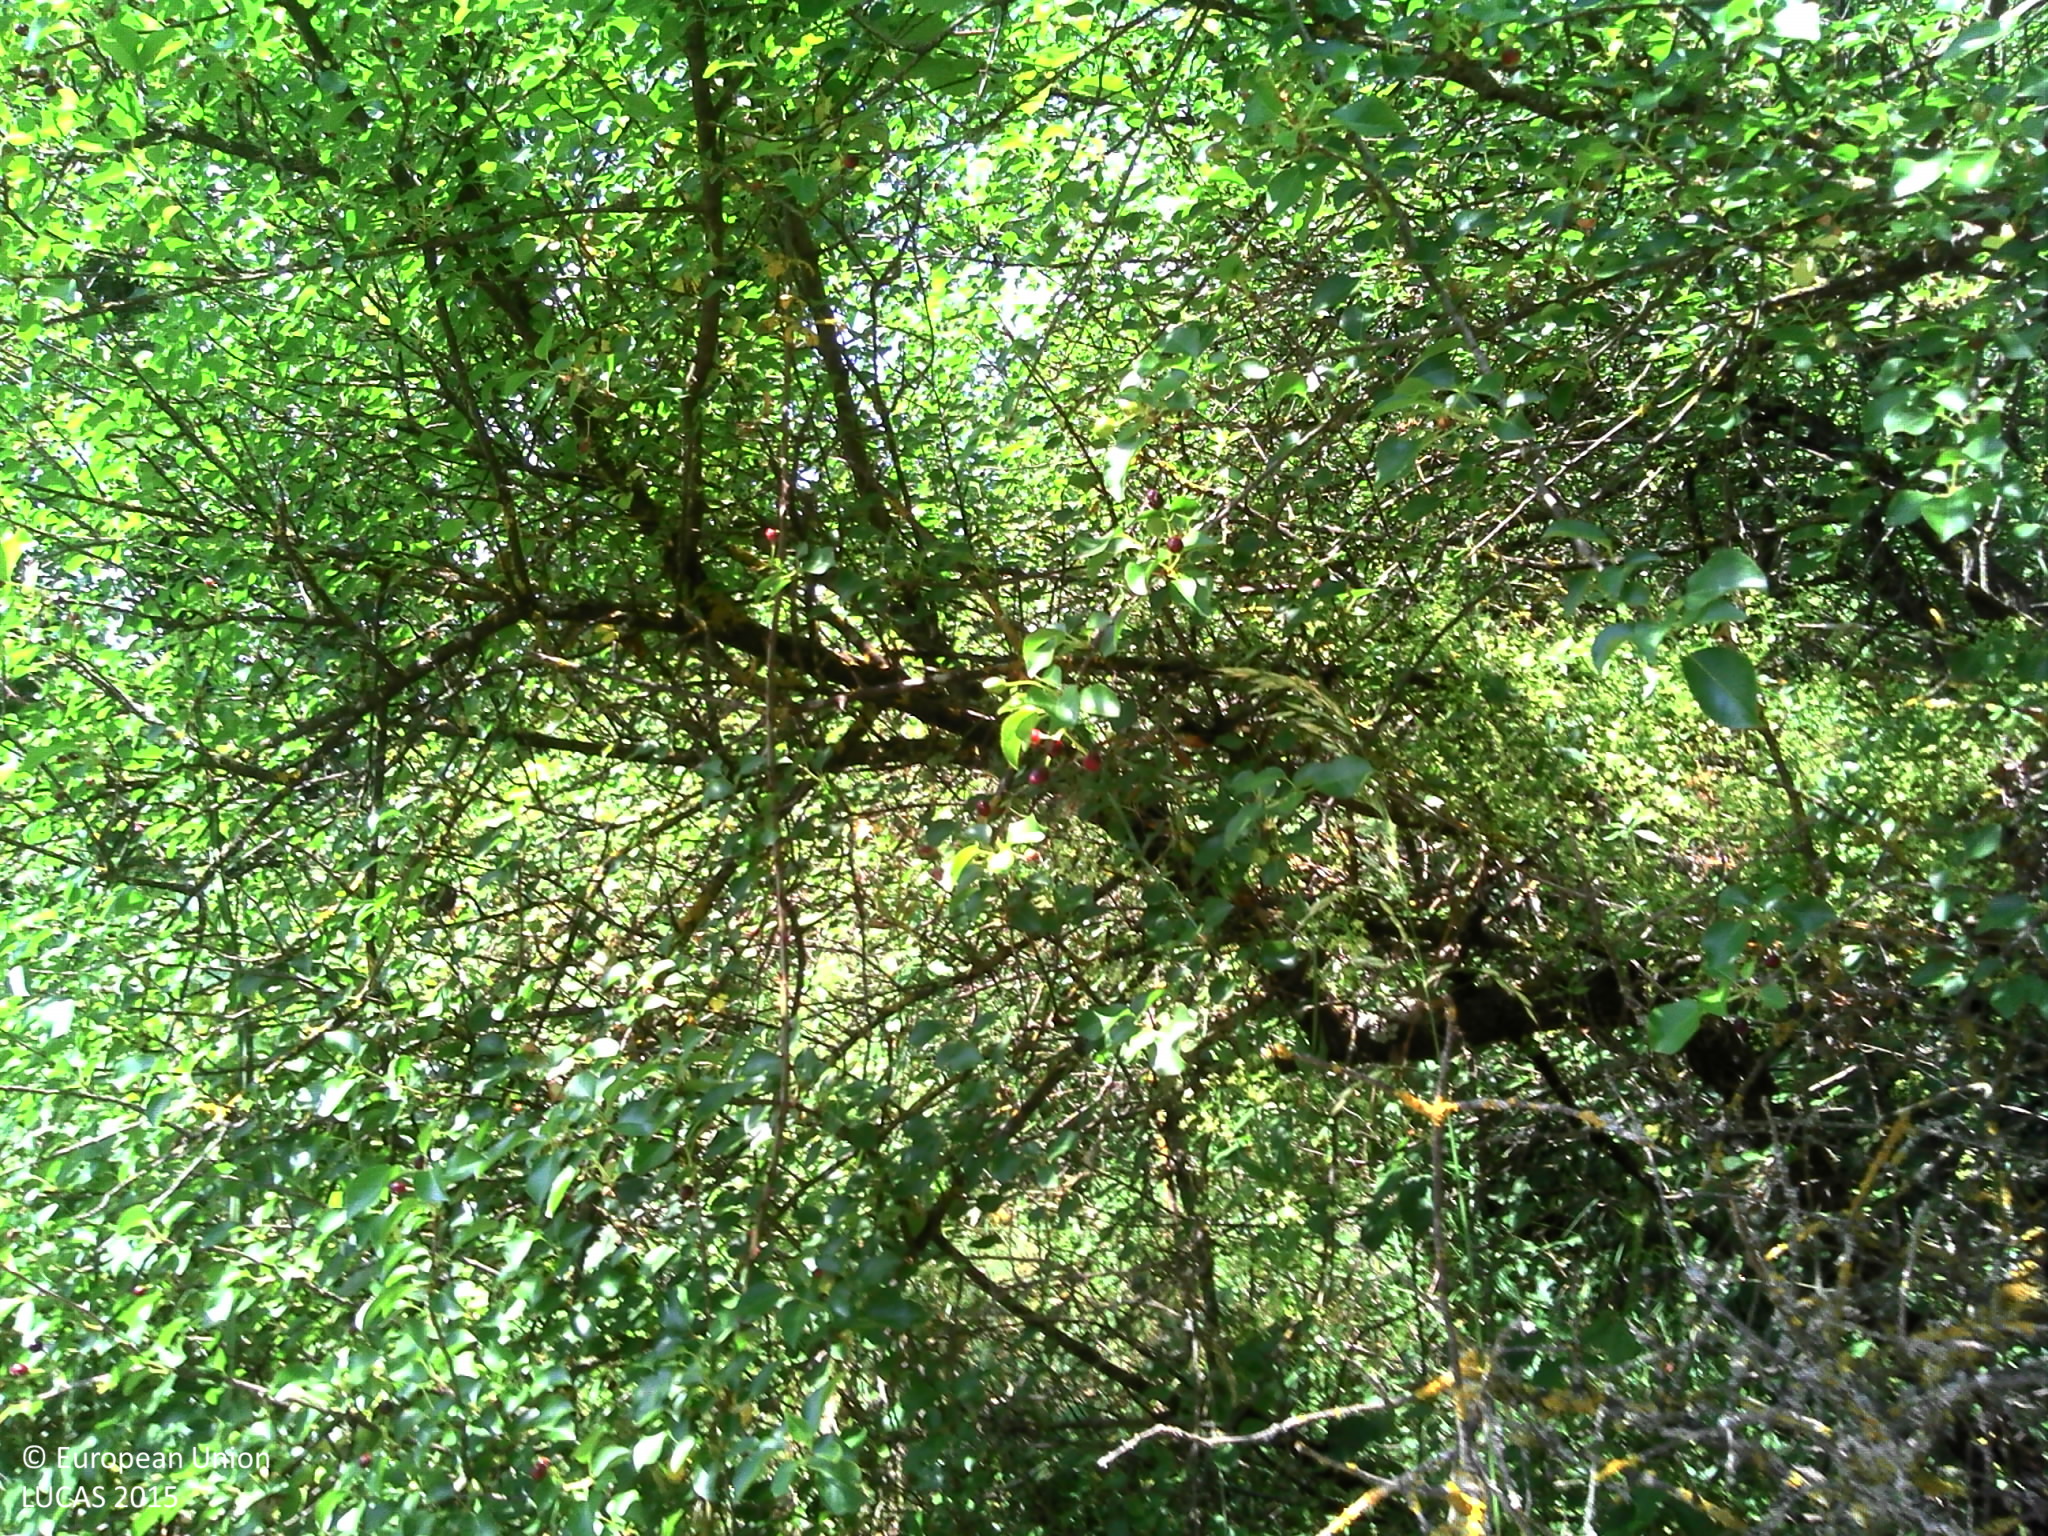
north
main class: Woodland
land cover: Broadleaved woodland
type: thermophilous deciduous forest
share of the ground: > 75 %
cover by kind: broadleaved forest trees 95 %, herbaceous plants 5 %
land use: Semi-natural and natural areas not in use
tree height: > 5 m
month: May
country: FR
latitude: 45.0029
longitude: 4.9183
